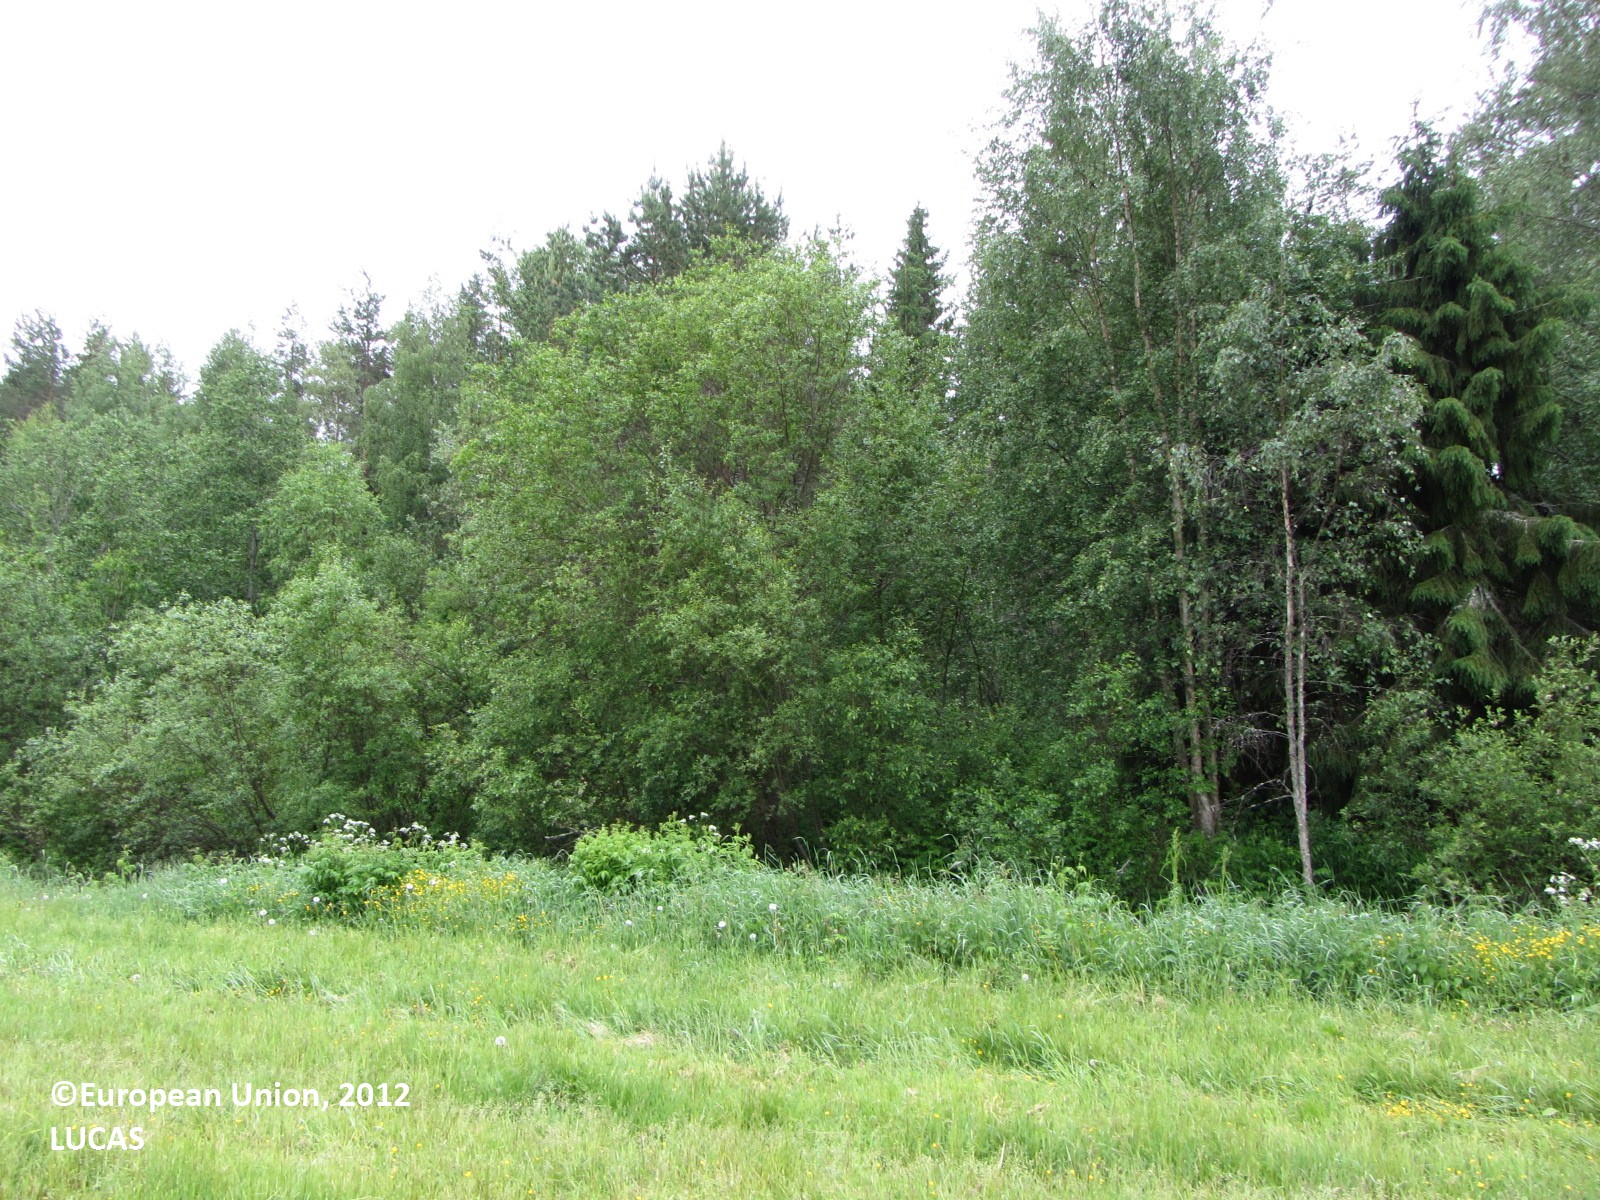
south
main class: Grassland
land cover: Grassland without tree/shrub cover
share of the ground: > 75 %
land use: Agriculture (excluding fallow land and kitchen gardens)
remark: Harvested field
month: June
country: FI
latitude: 62.6565
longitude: 25.2678
